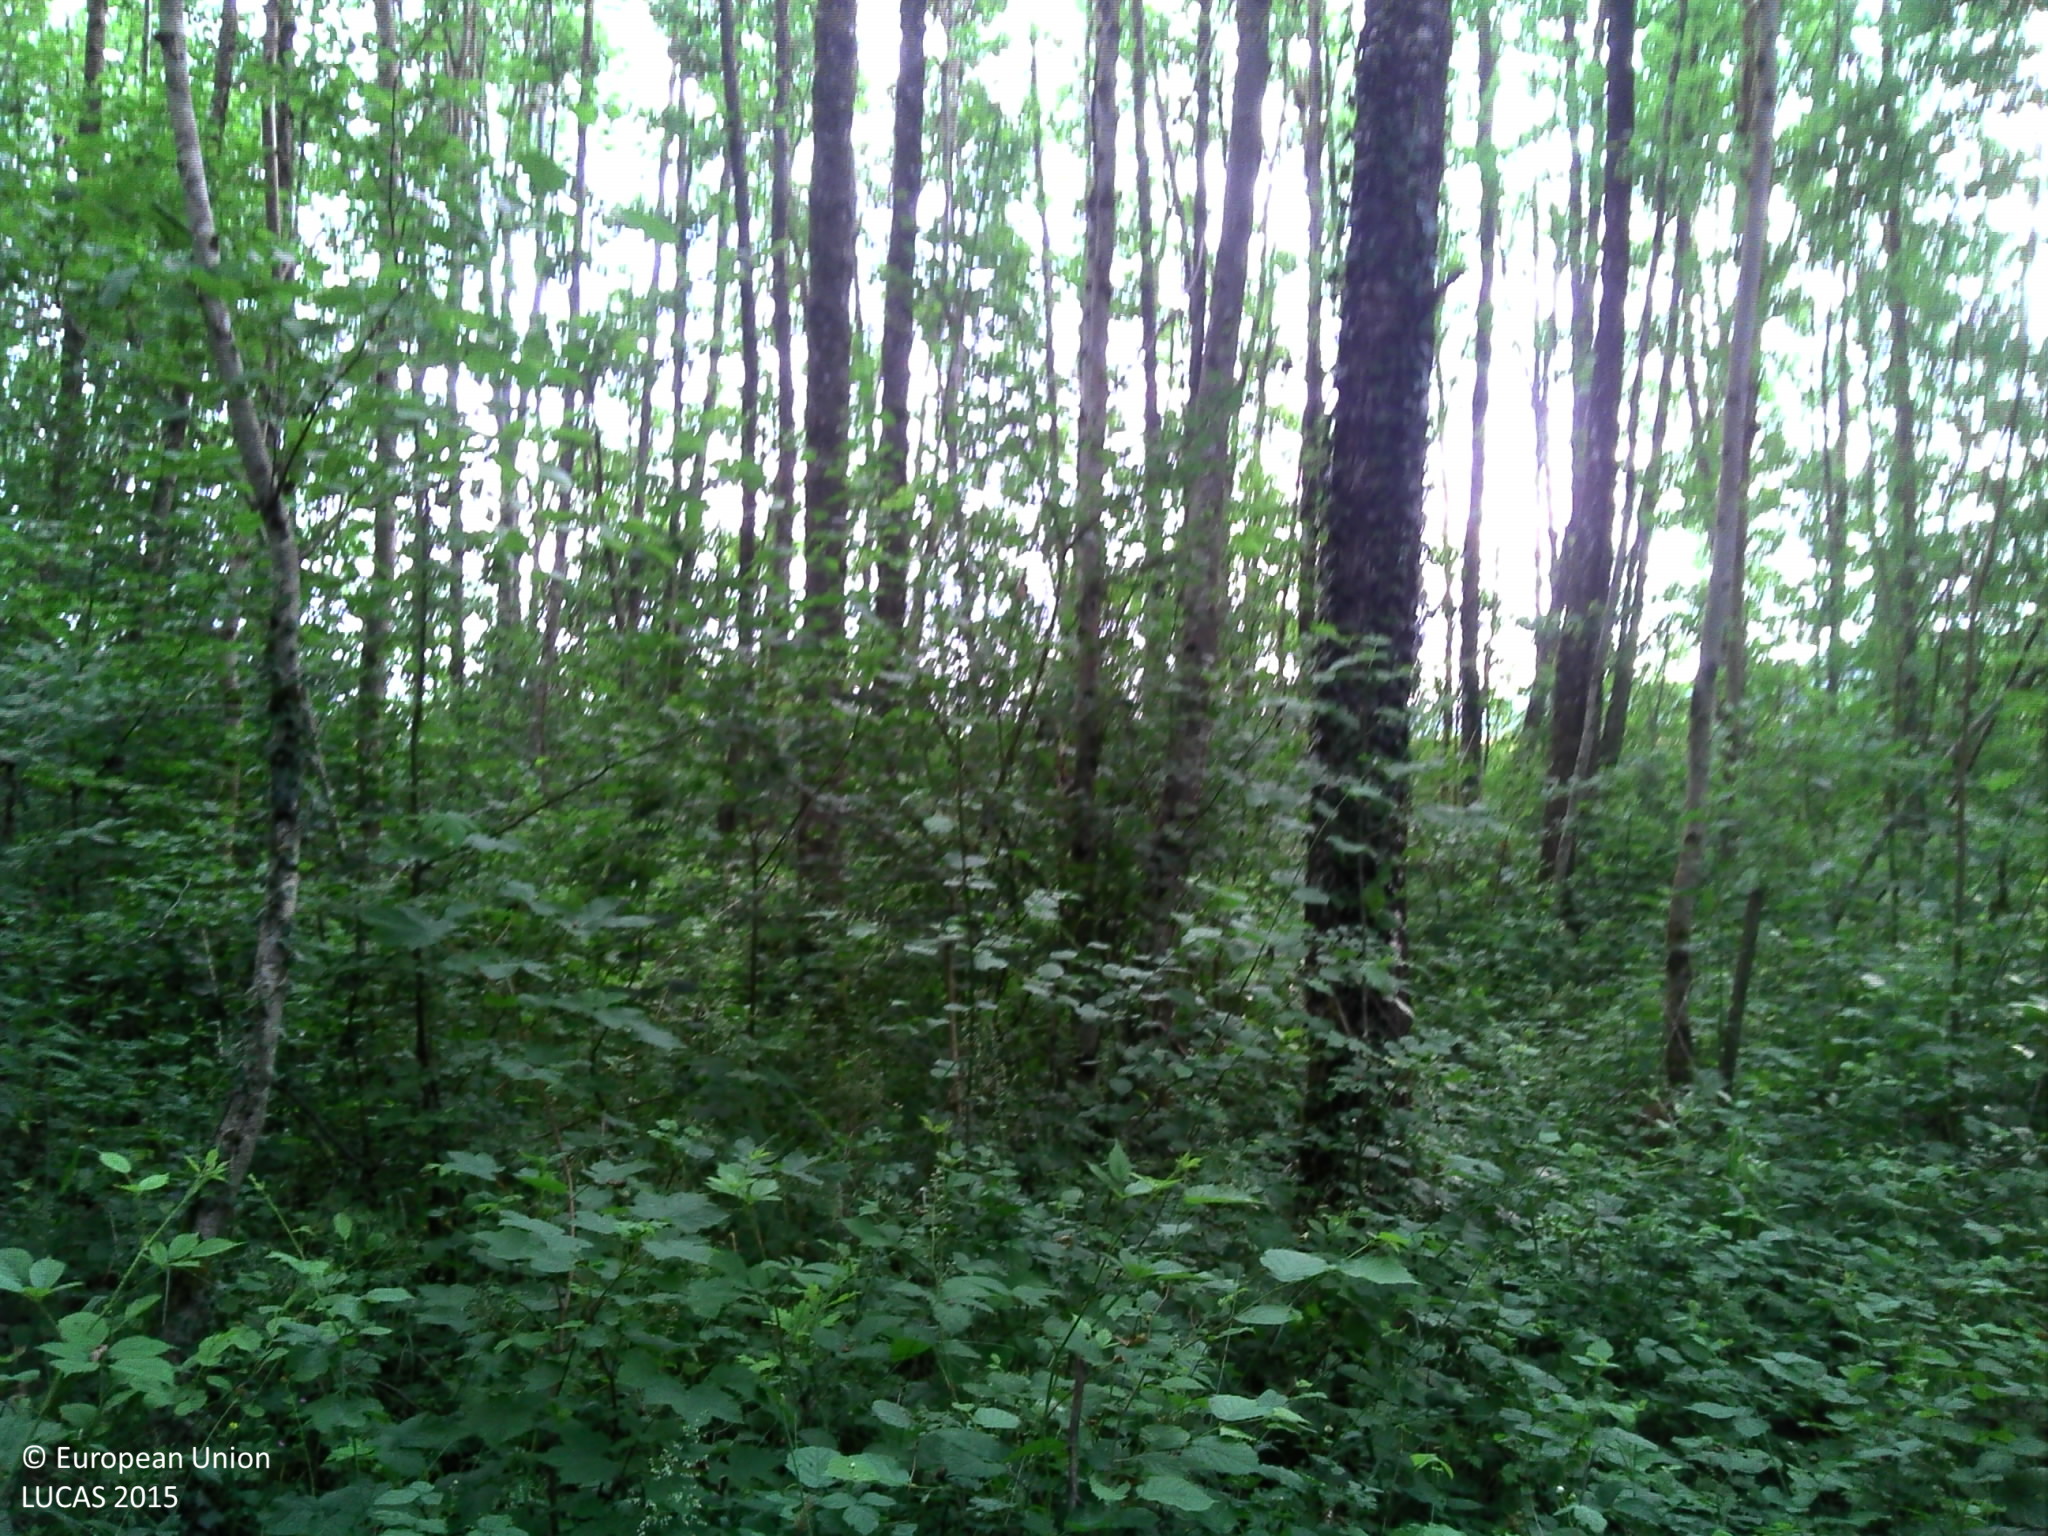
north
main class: Woodland
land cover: Broadleaved woodland
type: beech forest
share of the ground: > 75 %
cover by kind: broadleaved forest trees 90 %, herbaceous plants 10 %
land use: Forestry
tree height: > 5 m
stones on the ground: < 10 %
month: June
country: FR
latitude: 47.7114
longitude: 6.3092
